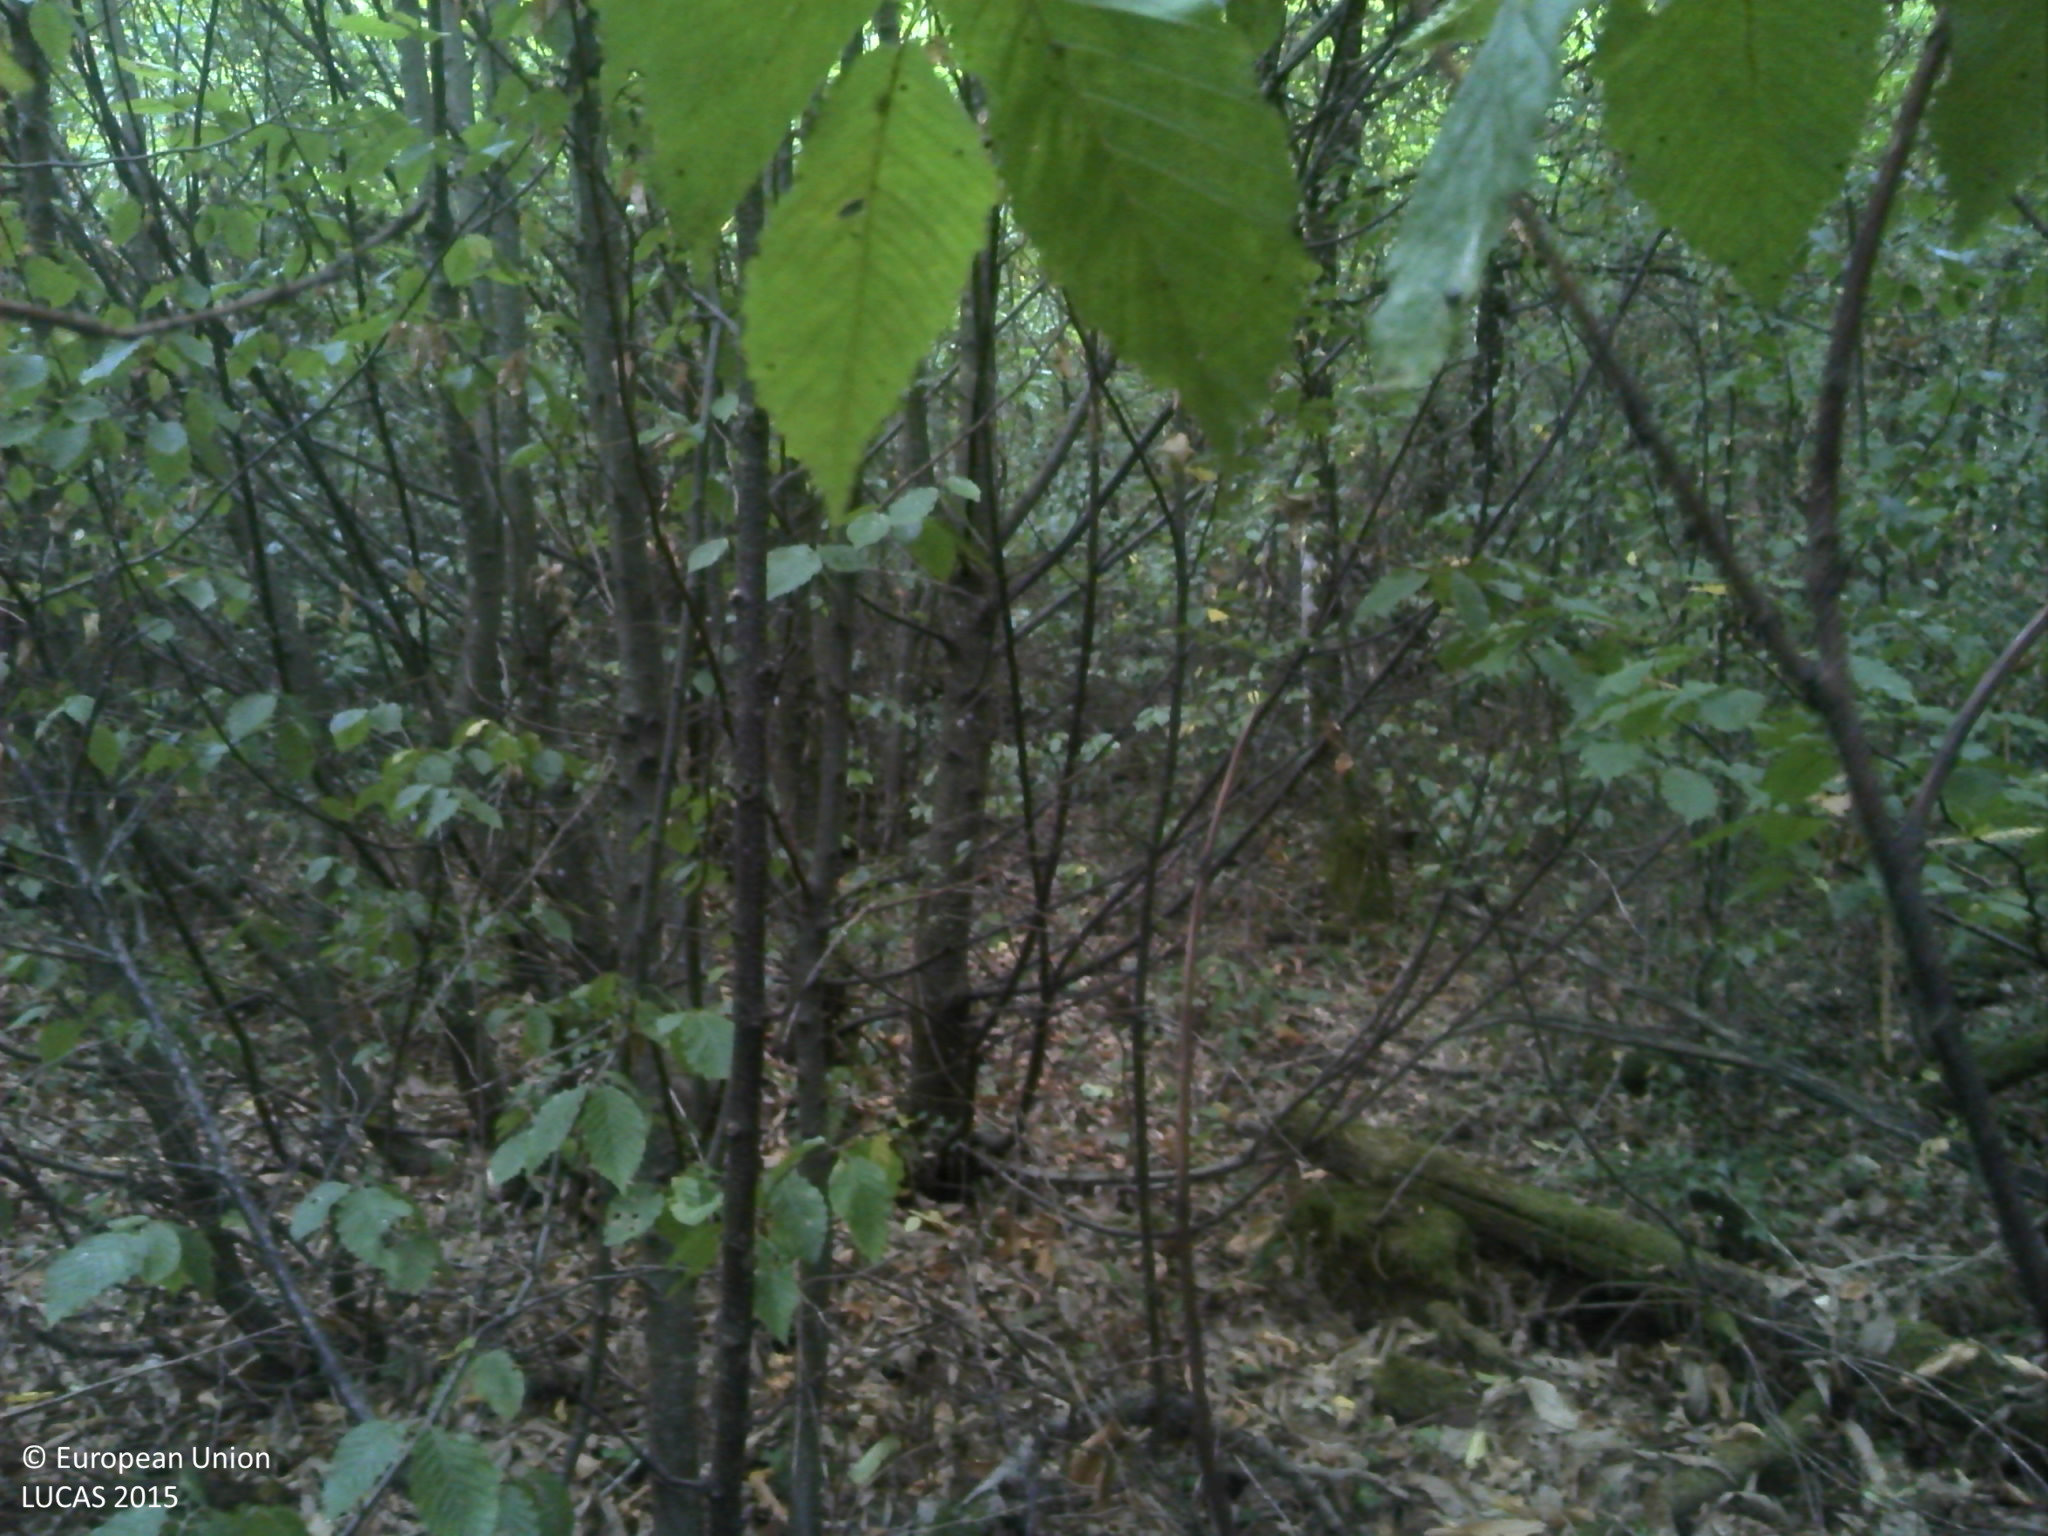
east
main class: Woodland
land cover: Broadleaved woodland
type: acidophilous oak and oak-birch forest
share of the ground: > 75 %
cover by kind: broadleaved forest trees 60 %, unconsolidated bare surface 30 %, herbaceous plants 5 %, lichens and mosses 5 %
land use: Semi-natural and natural areas not in use
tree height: > 5 m
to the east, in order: Broadleaved woodland; Fences; Grassland without tree/shrub cover; Fences; Dry pulses; Tomatoes; Fences; Rye; Artificial constructions in urban areas; Grassland without tree/shrub cover; Tracks; Grassland without tree/shrub cover
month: July
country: FR
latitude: 45.0269
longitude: 1.8621
